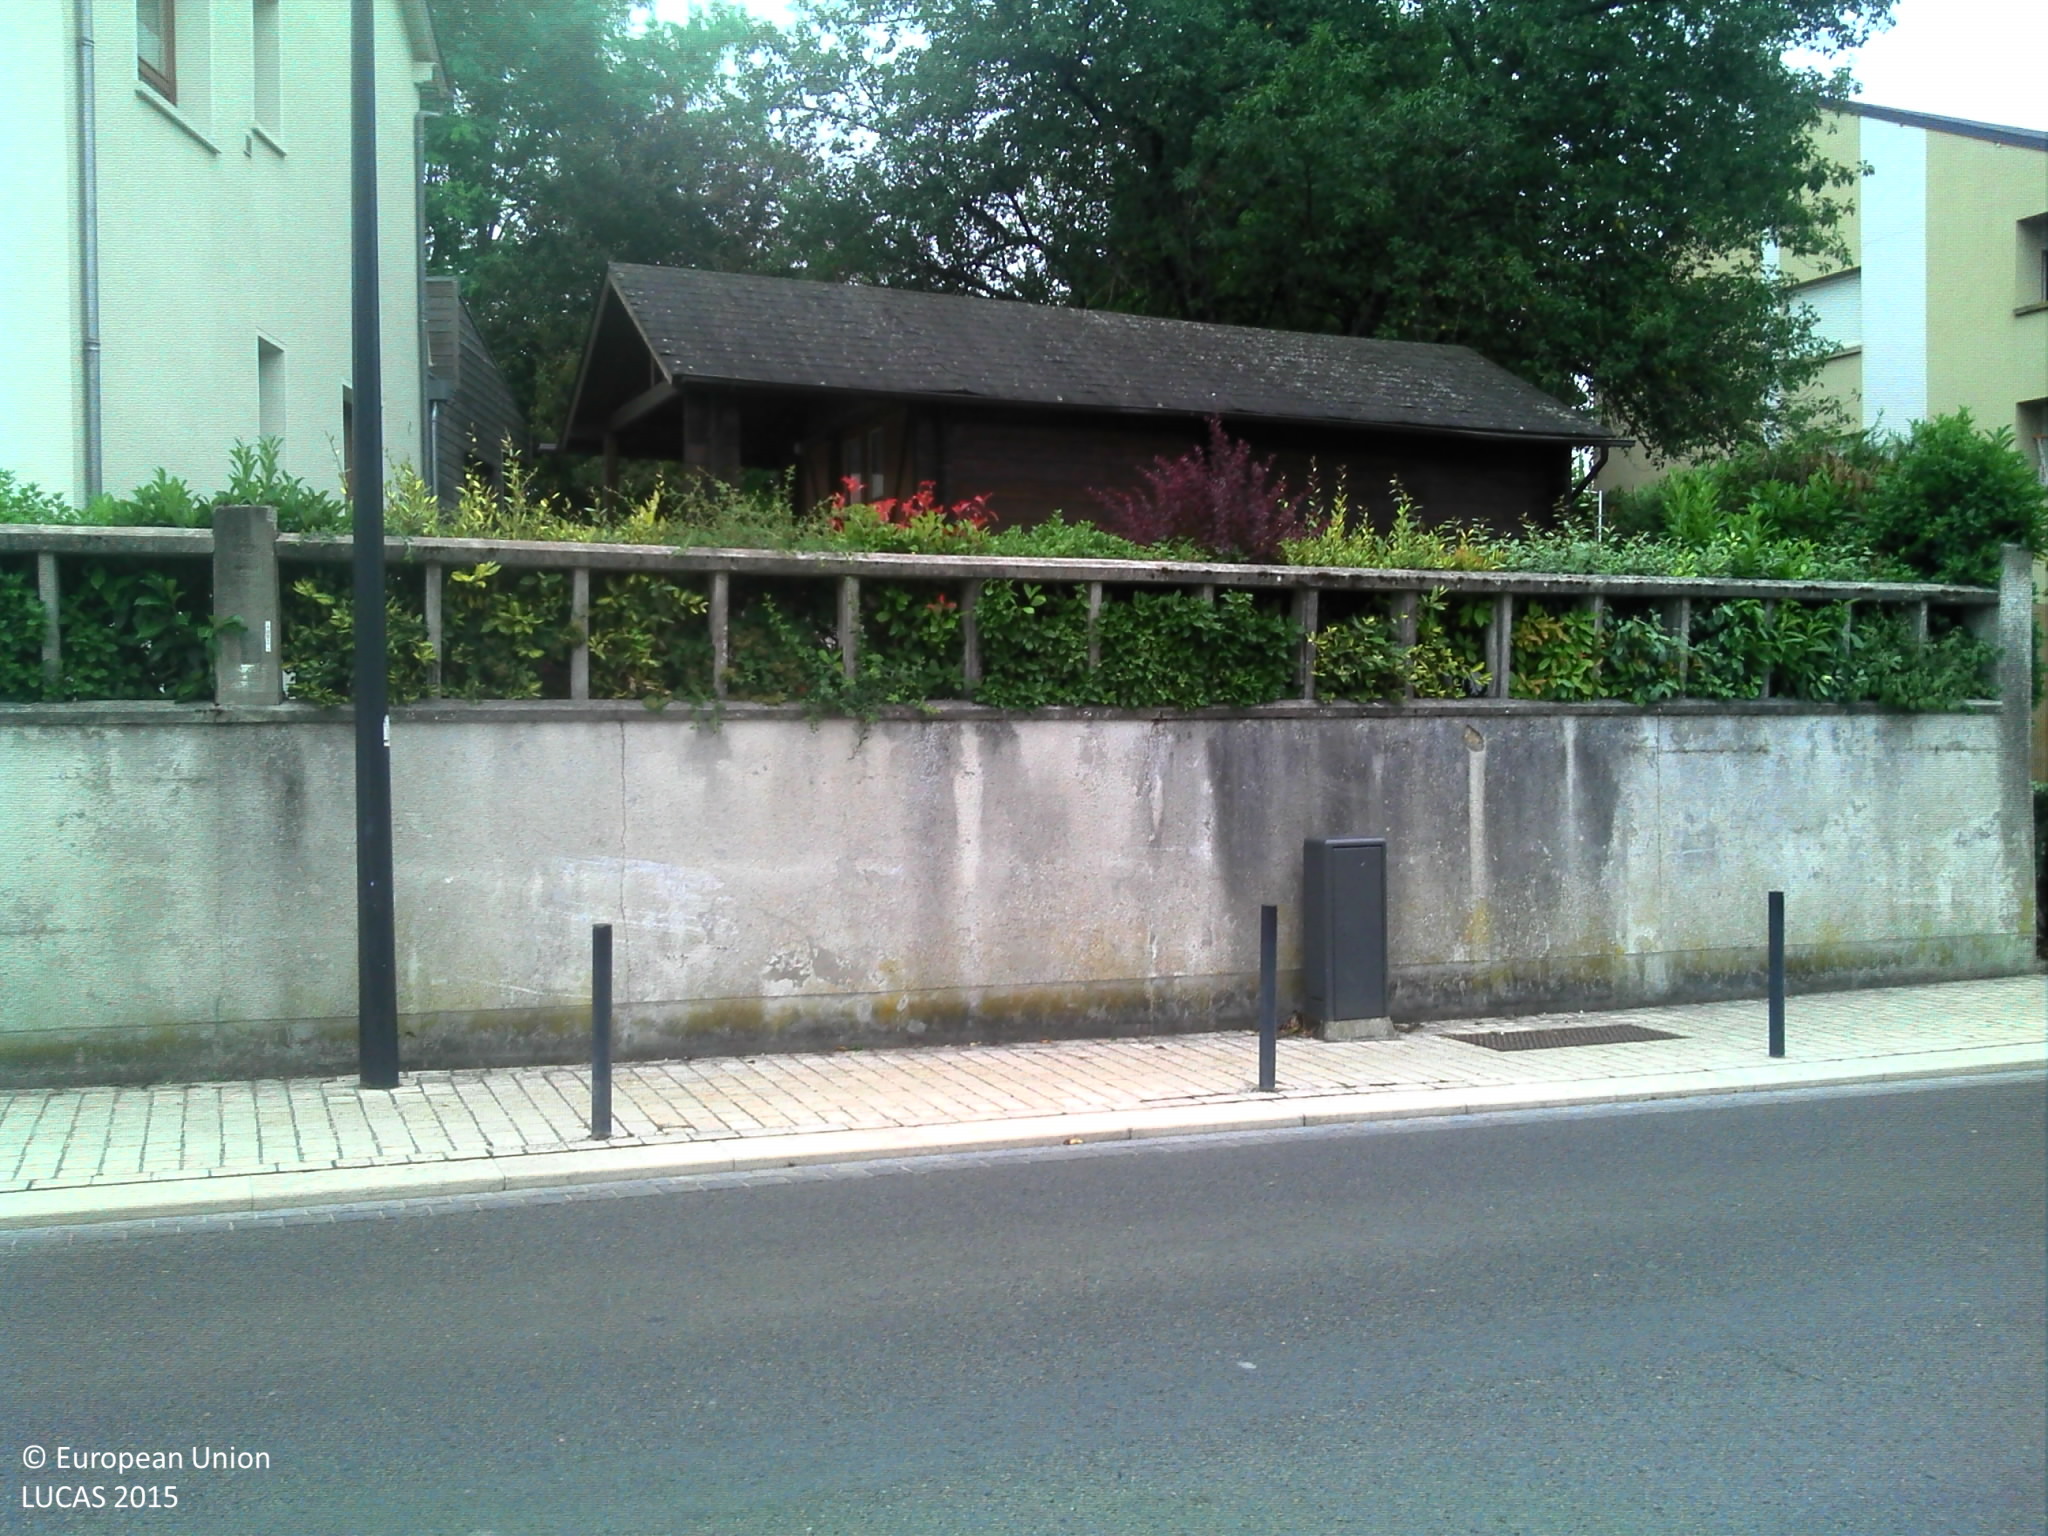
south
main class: Woodland
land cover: Broadleaved woodland
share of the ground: > 75 %
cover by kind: broadleaved forest trees 100 %
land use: Residential
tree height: > 5 m
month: July
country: FR
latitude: 47.9125
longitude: 1.9732
